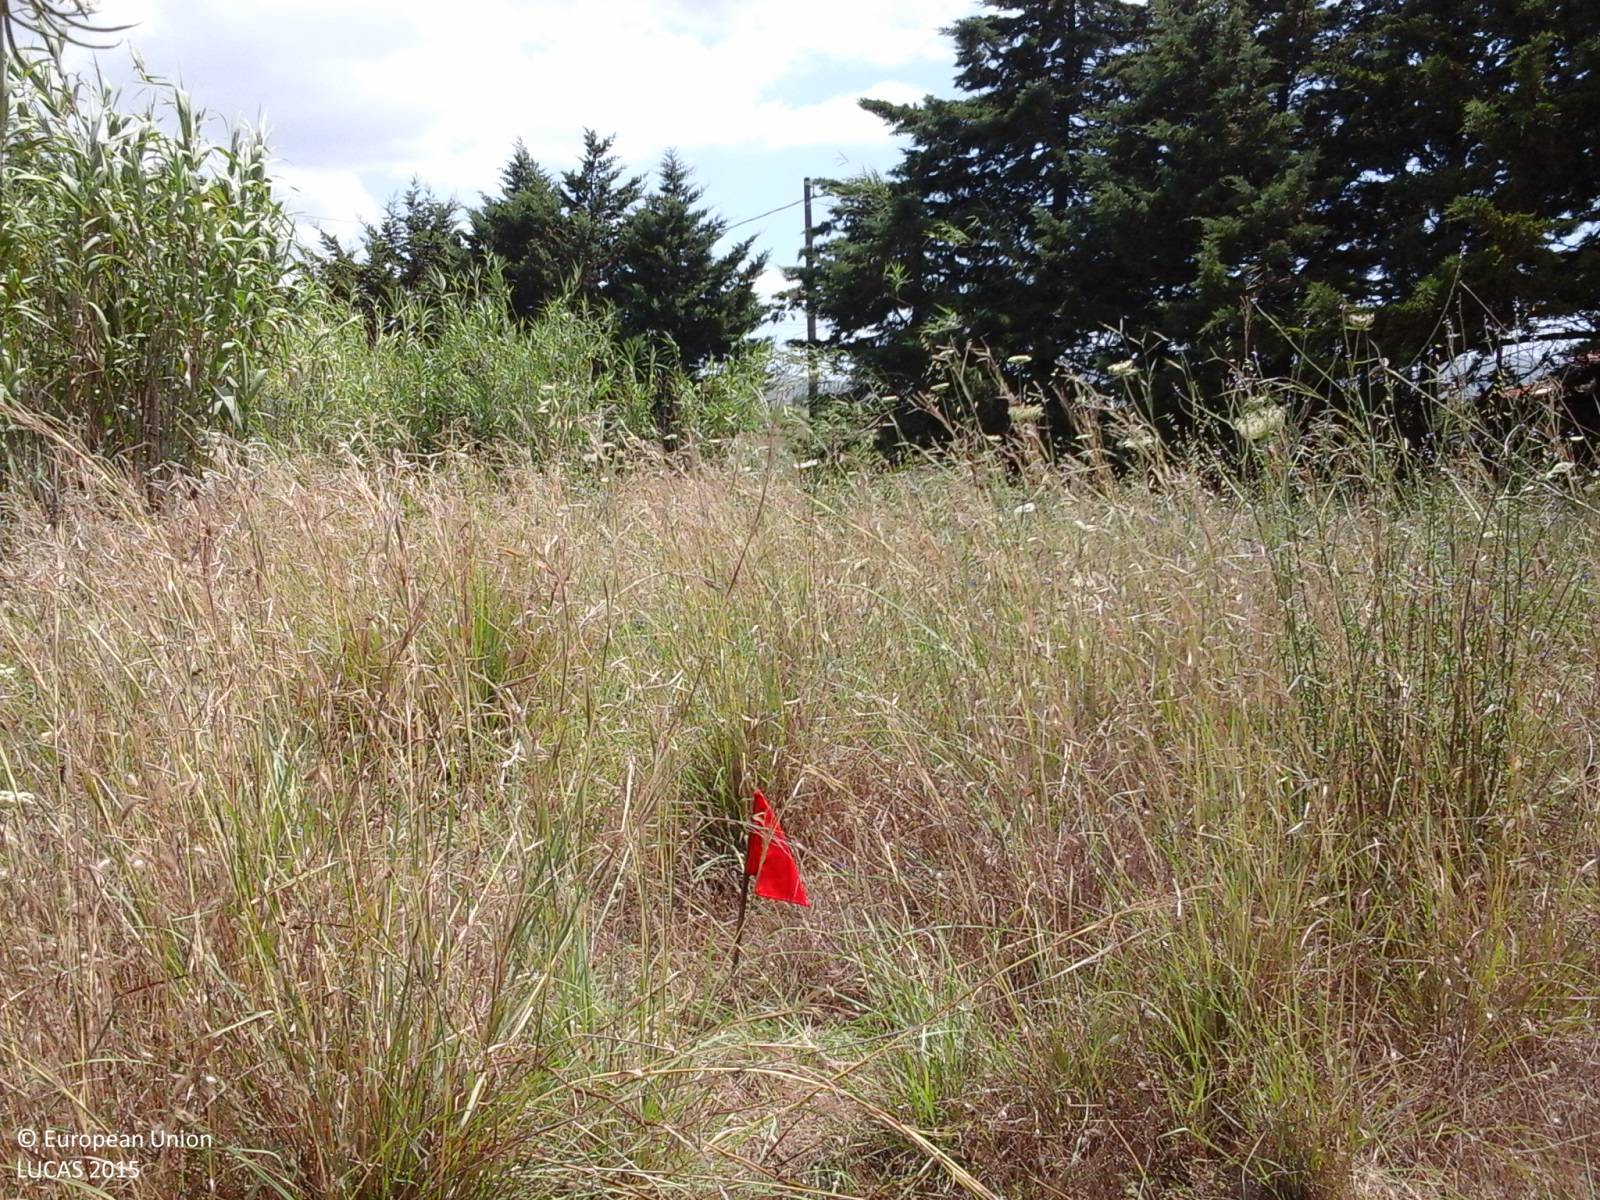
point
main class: Grassland
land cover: Grassland without tree/shrub cover
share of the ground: > 75 %
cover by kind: herbaceous plants 100 %
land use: Abandoned areas
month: June
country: IT
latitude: 38.0243
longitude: 13.0879
